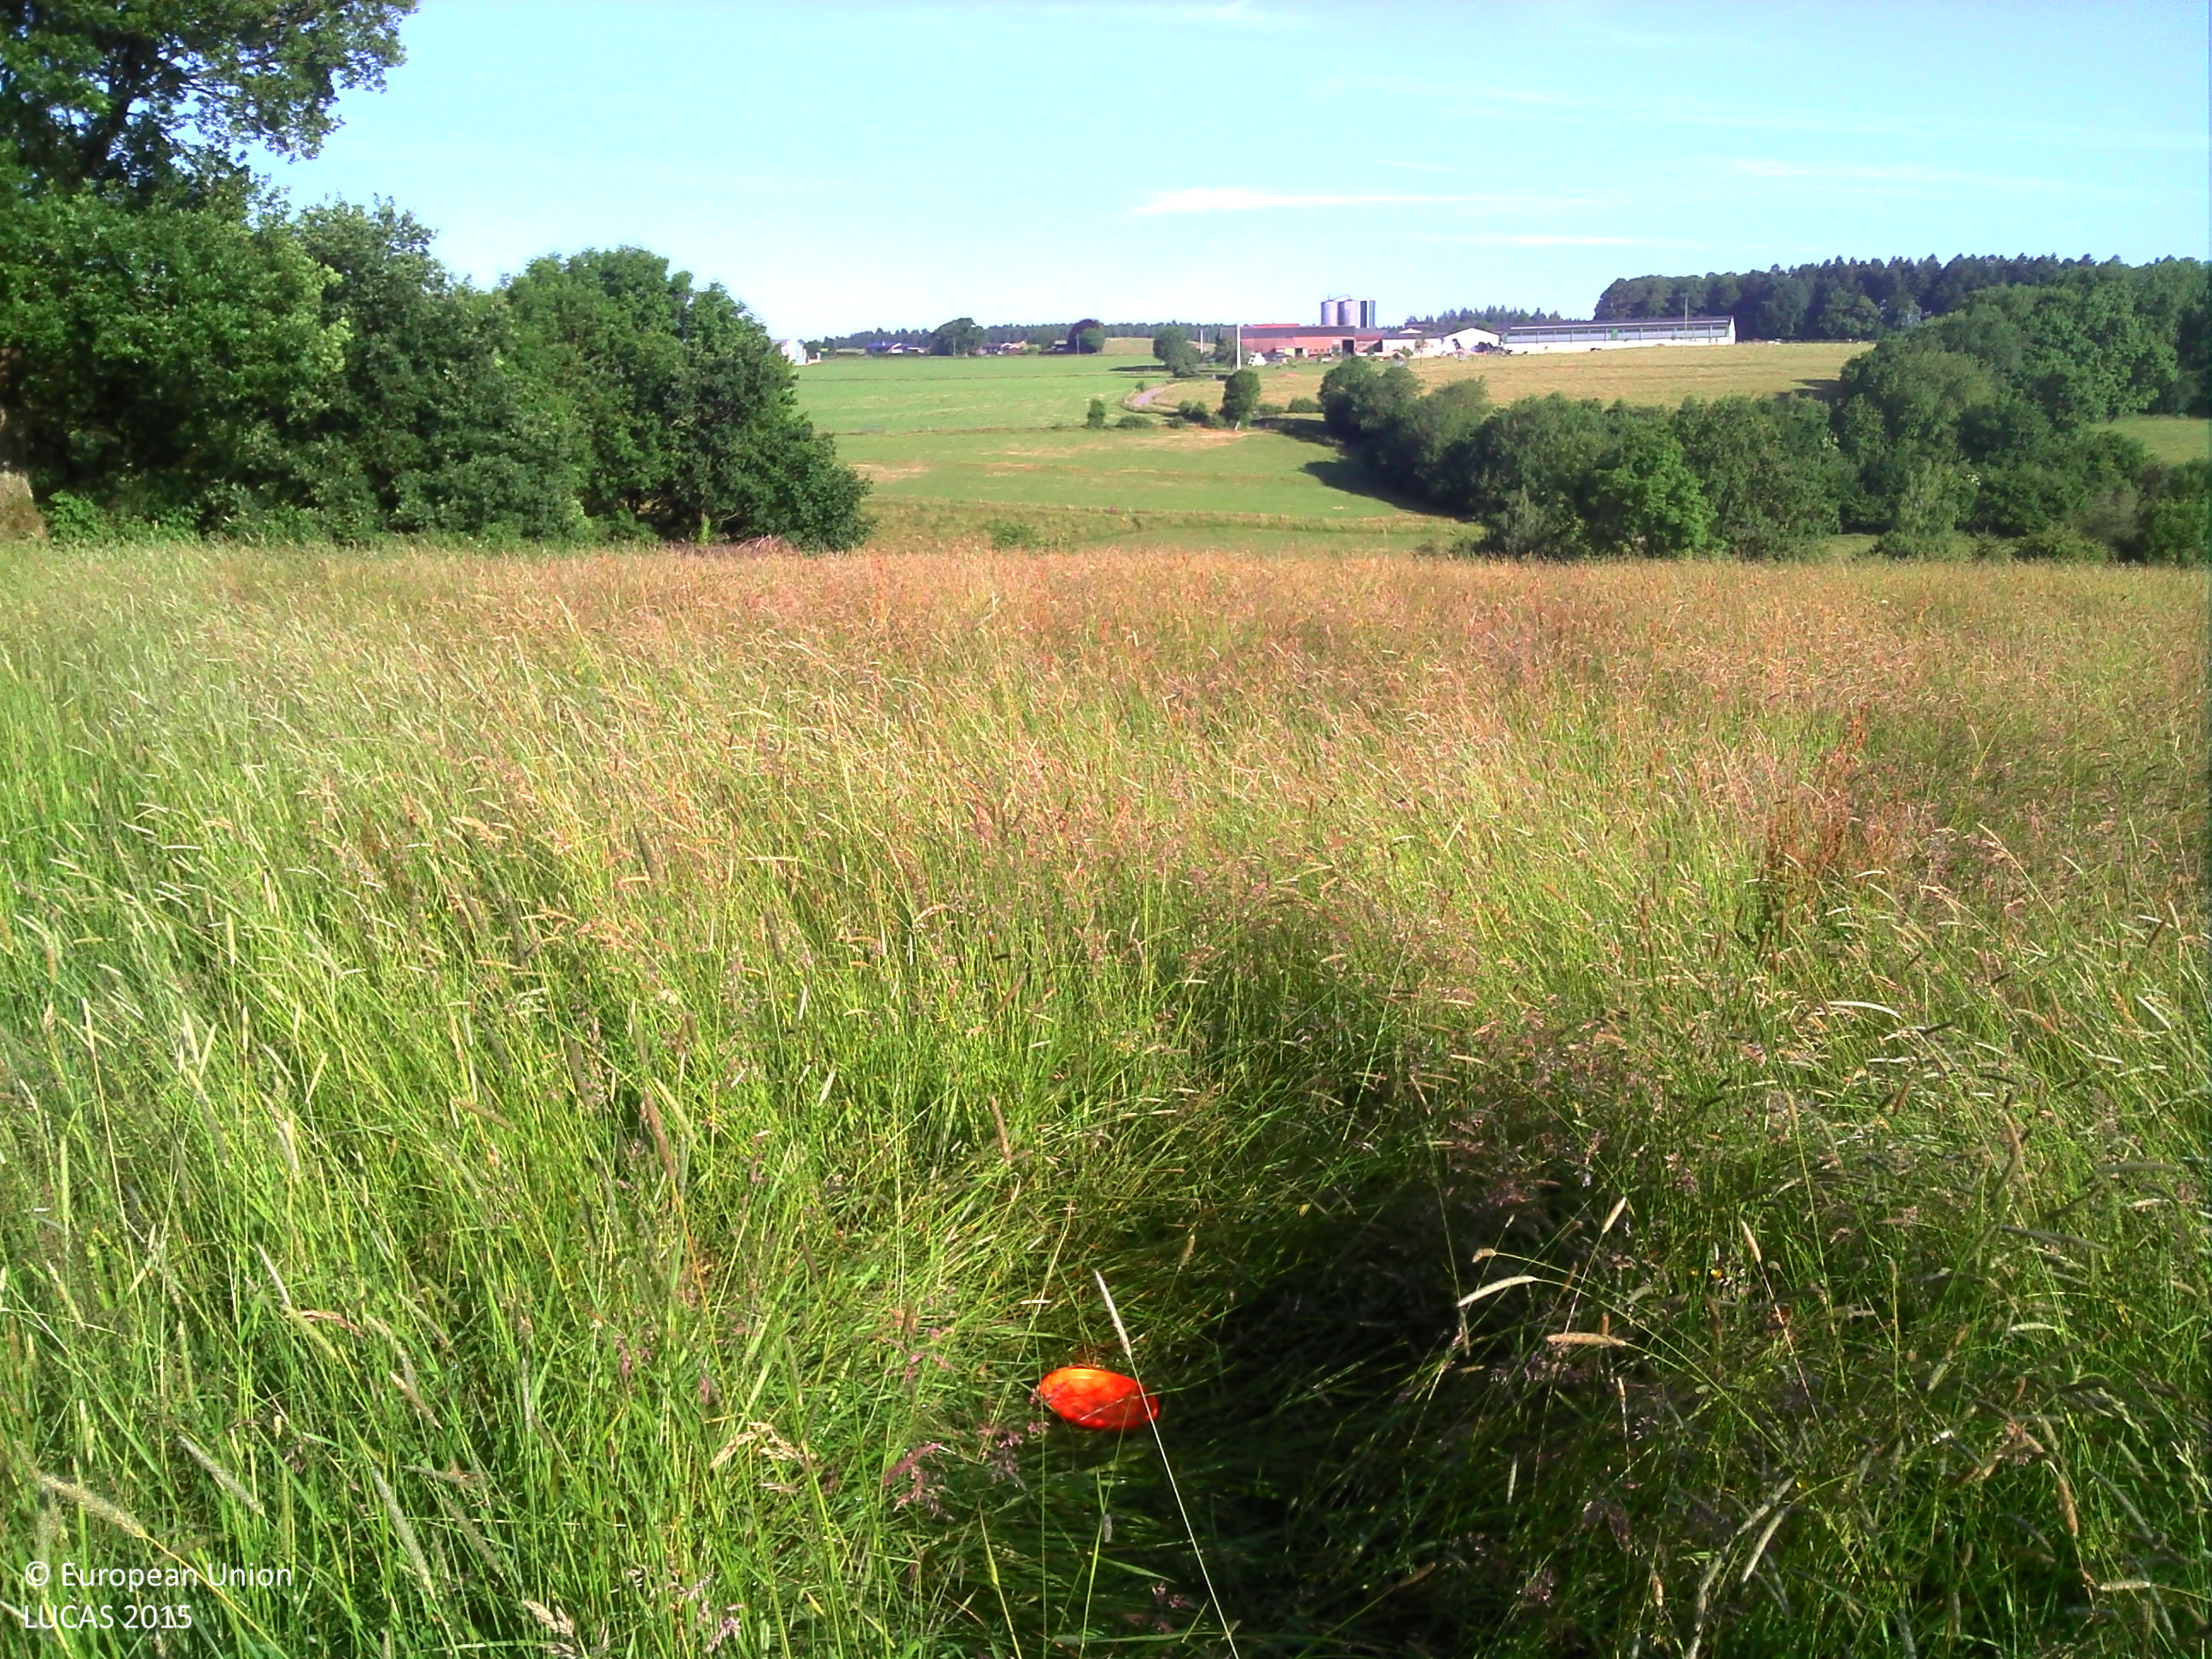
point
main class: Grassland
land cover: Grassland without tree/shrub cover
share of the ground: > 75 %
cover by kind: herbaceous plants 100 %
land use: Agriculture (excluding fallow land and kitchen gardens)
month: June
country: BE
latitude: 50.5024
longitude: 5.7831
